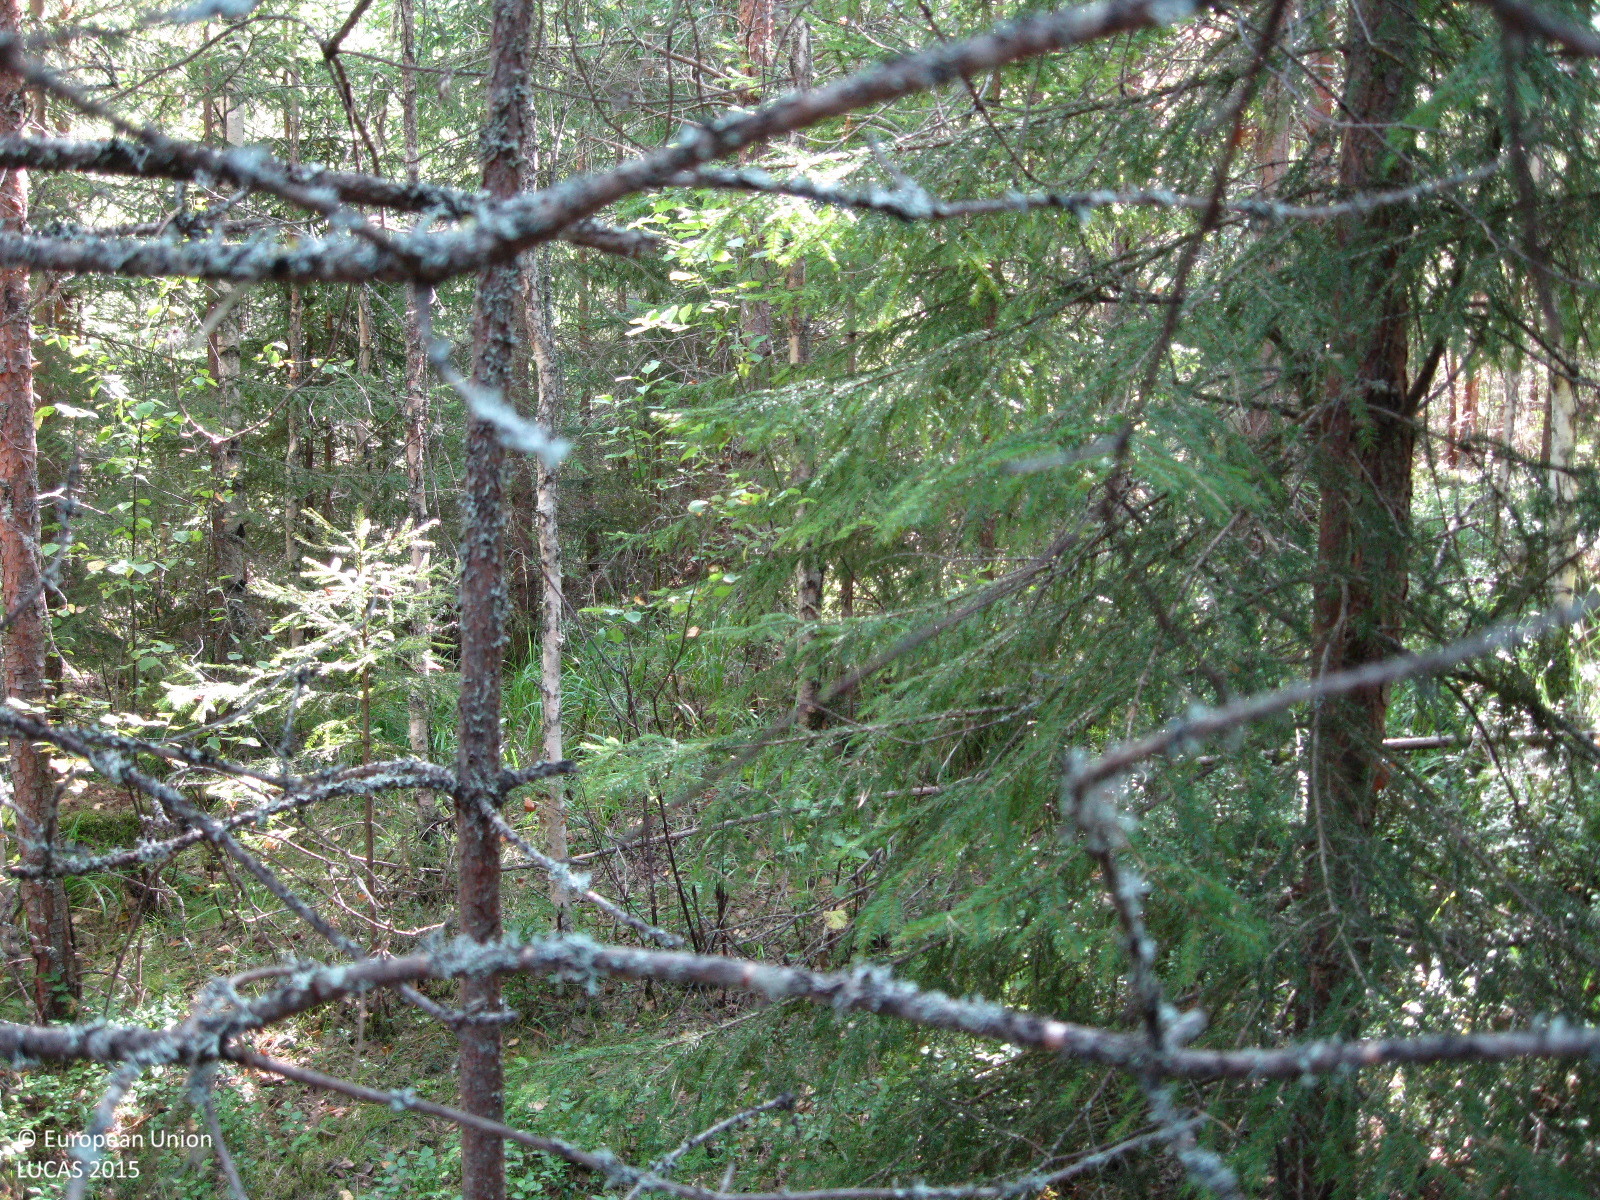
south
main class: Woodland
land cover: Other mixed woodland
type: boreal forest
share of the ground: > 75 %
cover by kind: coniferous forest trees 65 %, broadleaved forest trees 25 %, shrubs 5 %, lichens and mosses 5 %
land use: Forestry
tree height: > 5 m
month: August
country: FI
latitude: 61.4223
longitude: 25.0853
